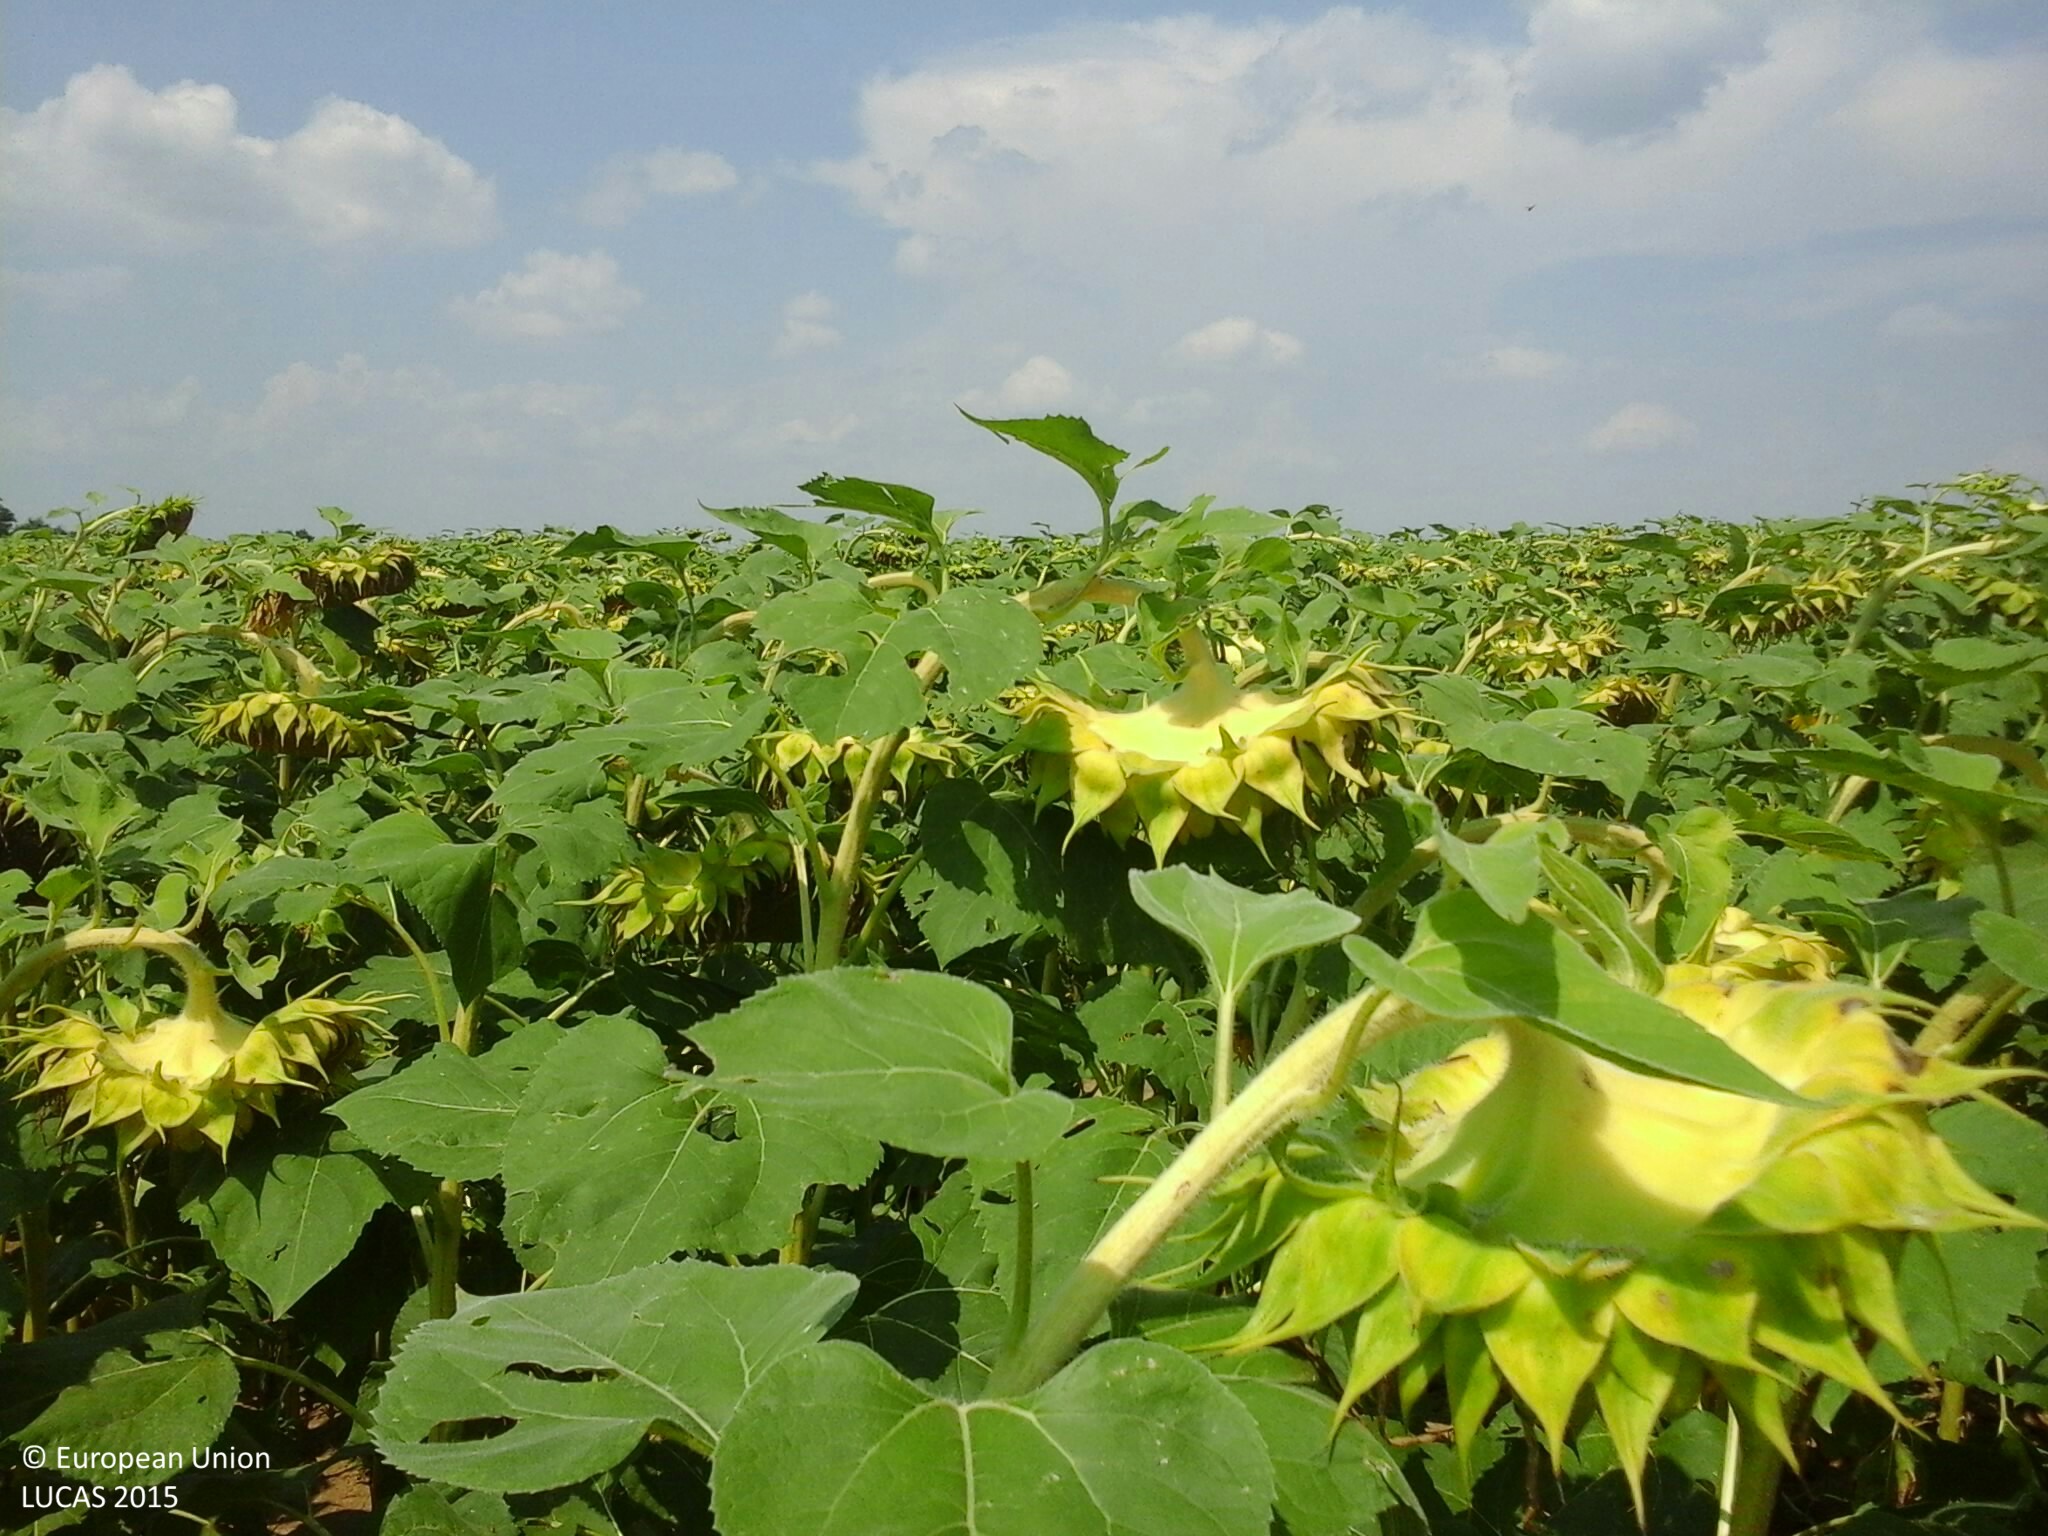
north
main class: Cropland
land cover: Sunflower
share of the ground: > 75 %
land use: Agriculture (excluding fallow land and kitchen gardens)
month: August
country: HU
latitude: 45.9238
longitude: 18.2464
